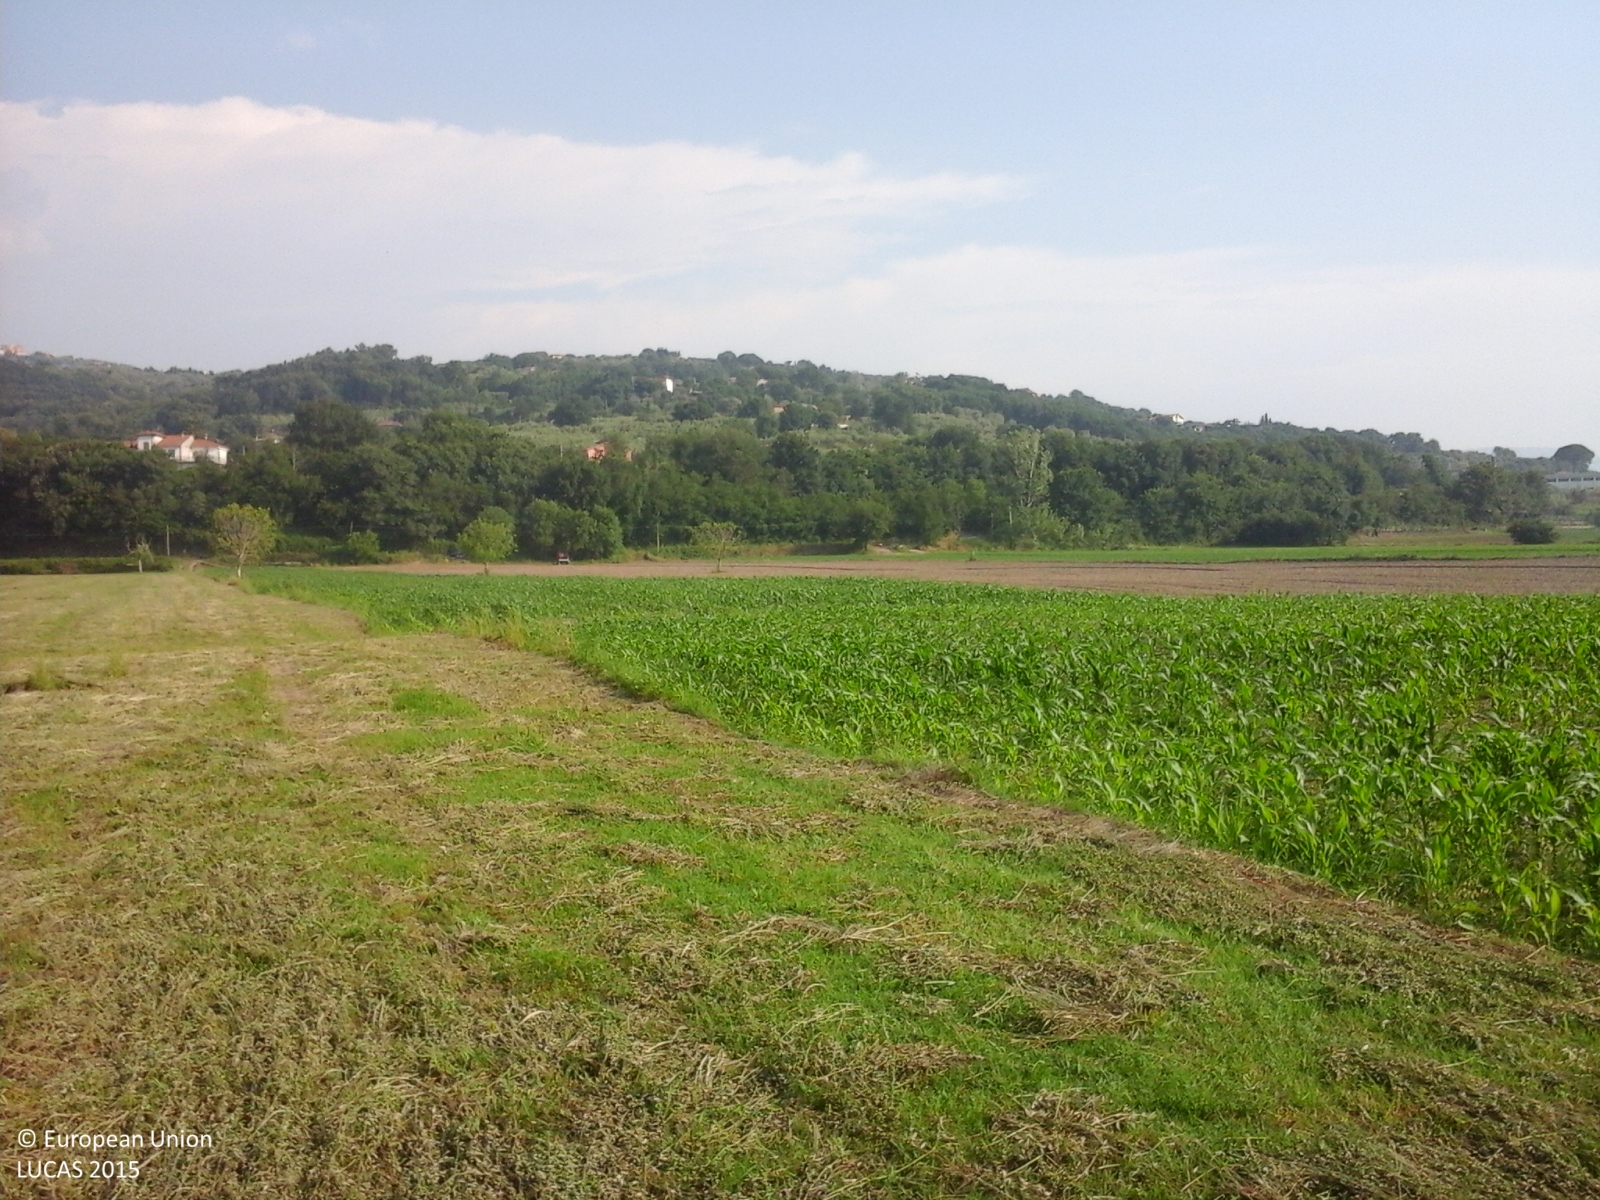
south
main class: Cropland
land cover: Other leguminous and mixtures for fodder
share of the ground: > 75 %
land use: Agriculture (excluding fallow land and kitchen gardens)
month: June
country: IT
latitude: 40.5508
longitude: 15.1154
